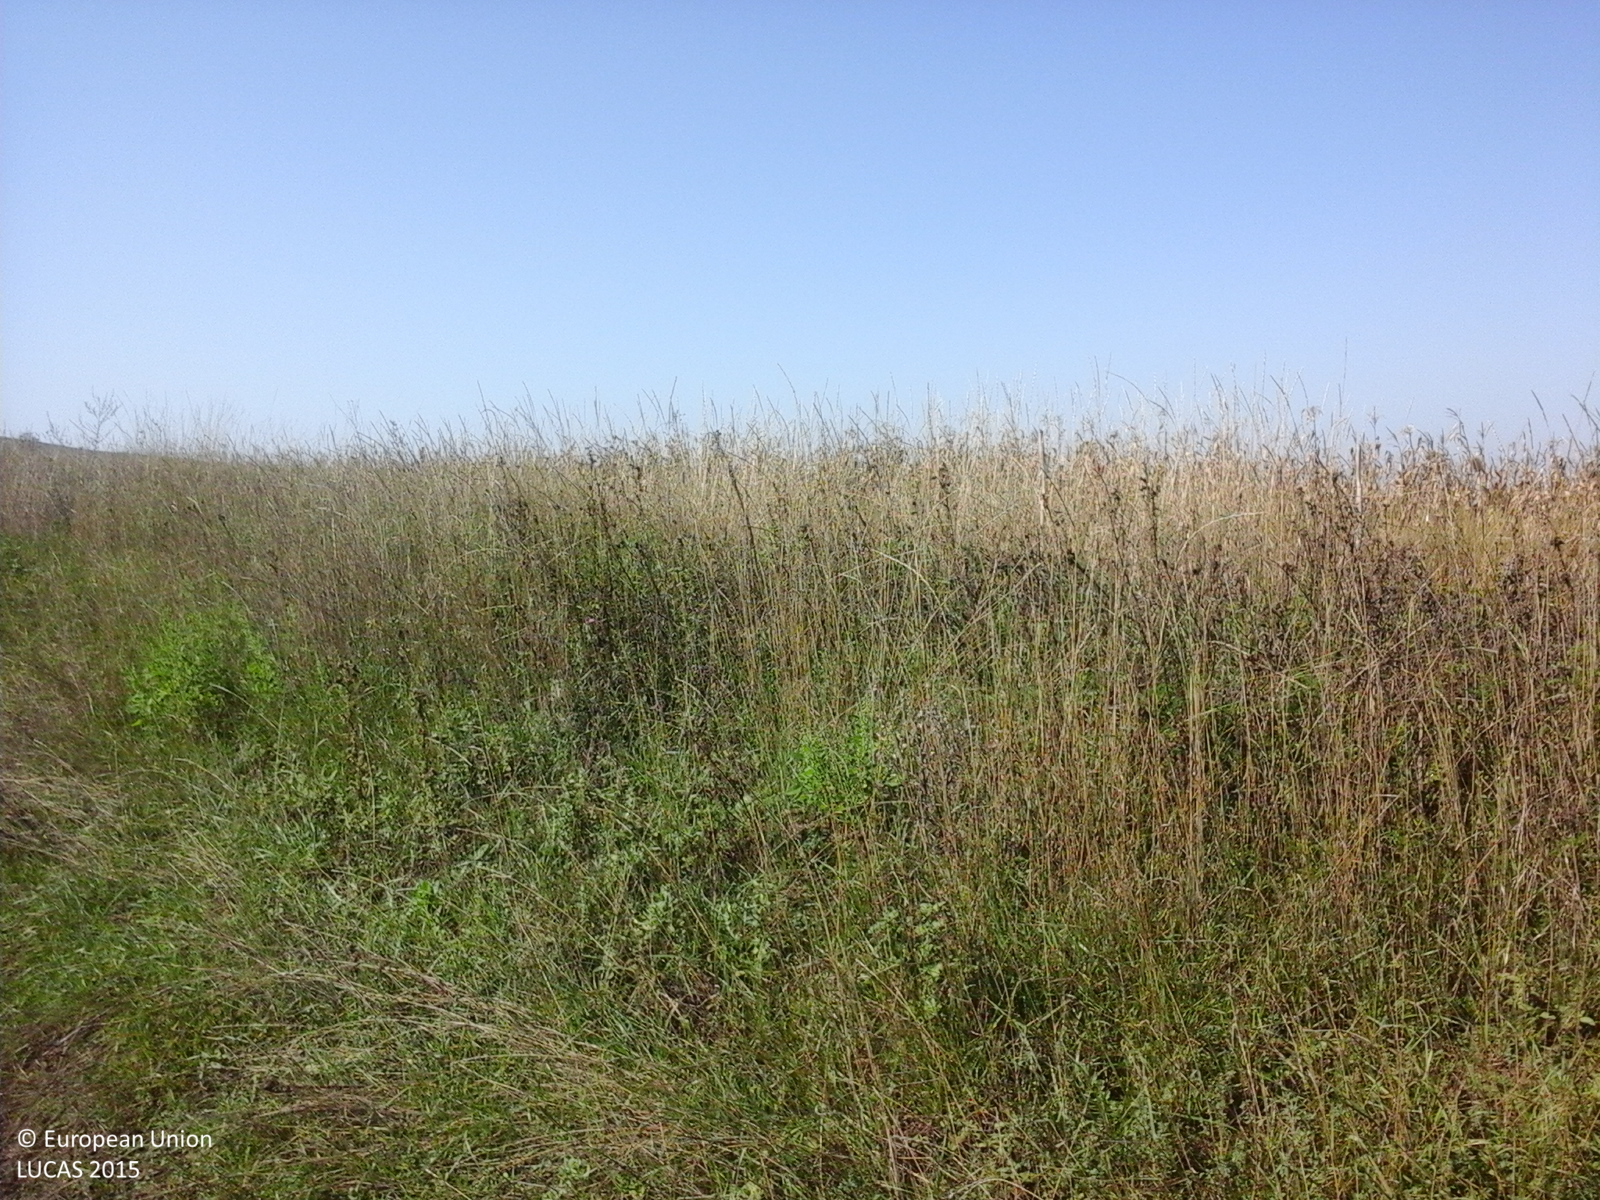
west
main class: Cropland
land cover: Maize
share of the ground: > 75 %
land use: Agriculture (excluding fallow land and kitchen gardens)
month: October
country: RO
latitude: 46.1203
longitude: 23.8532
